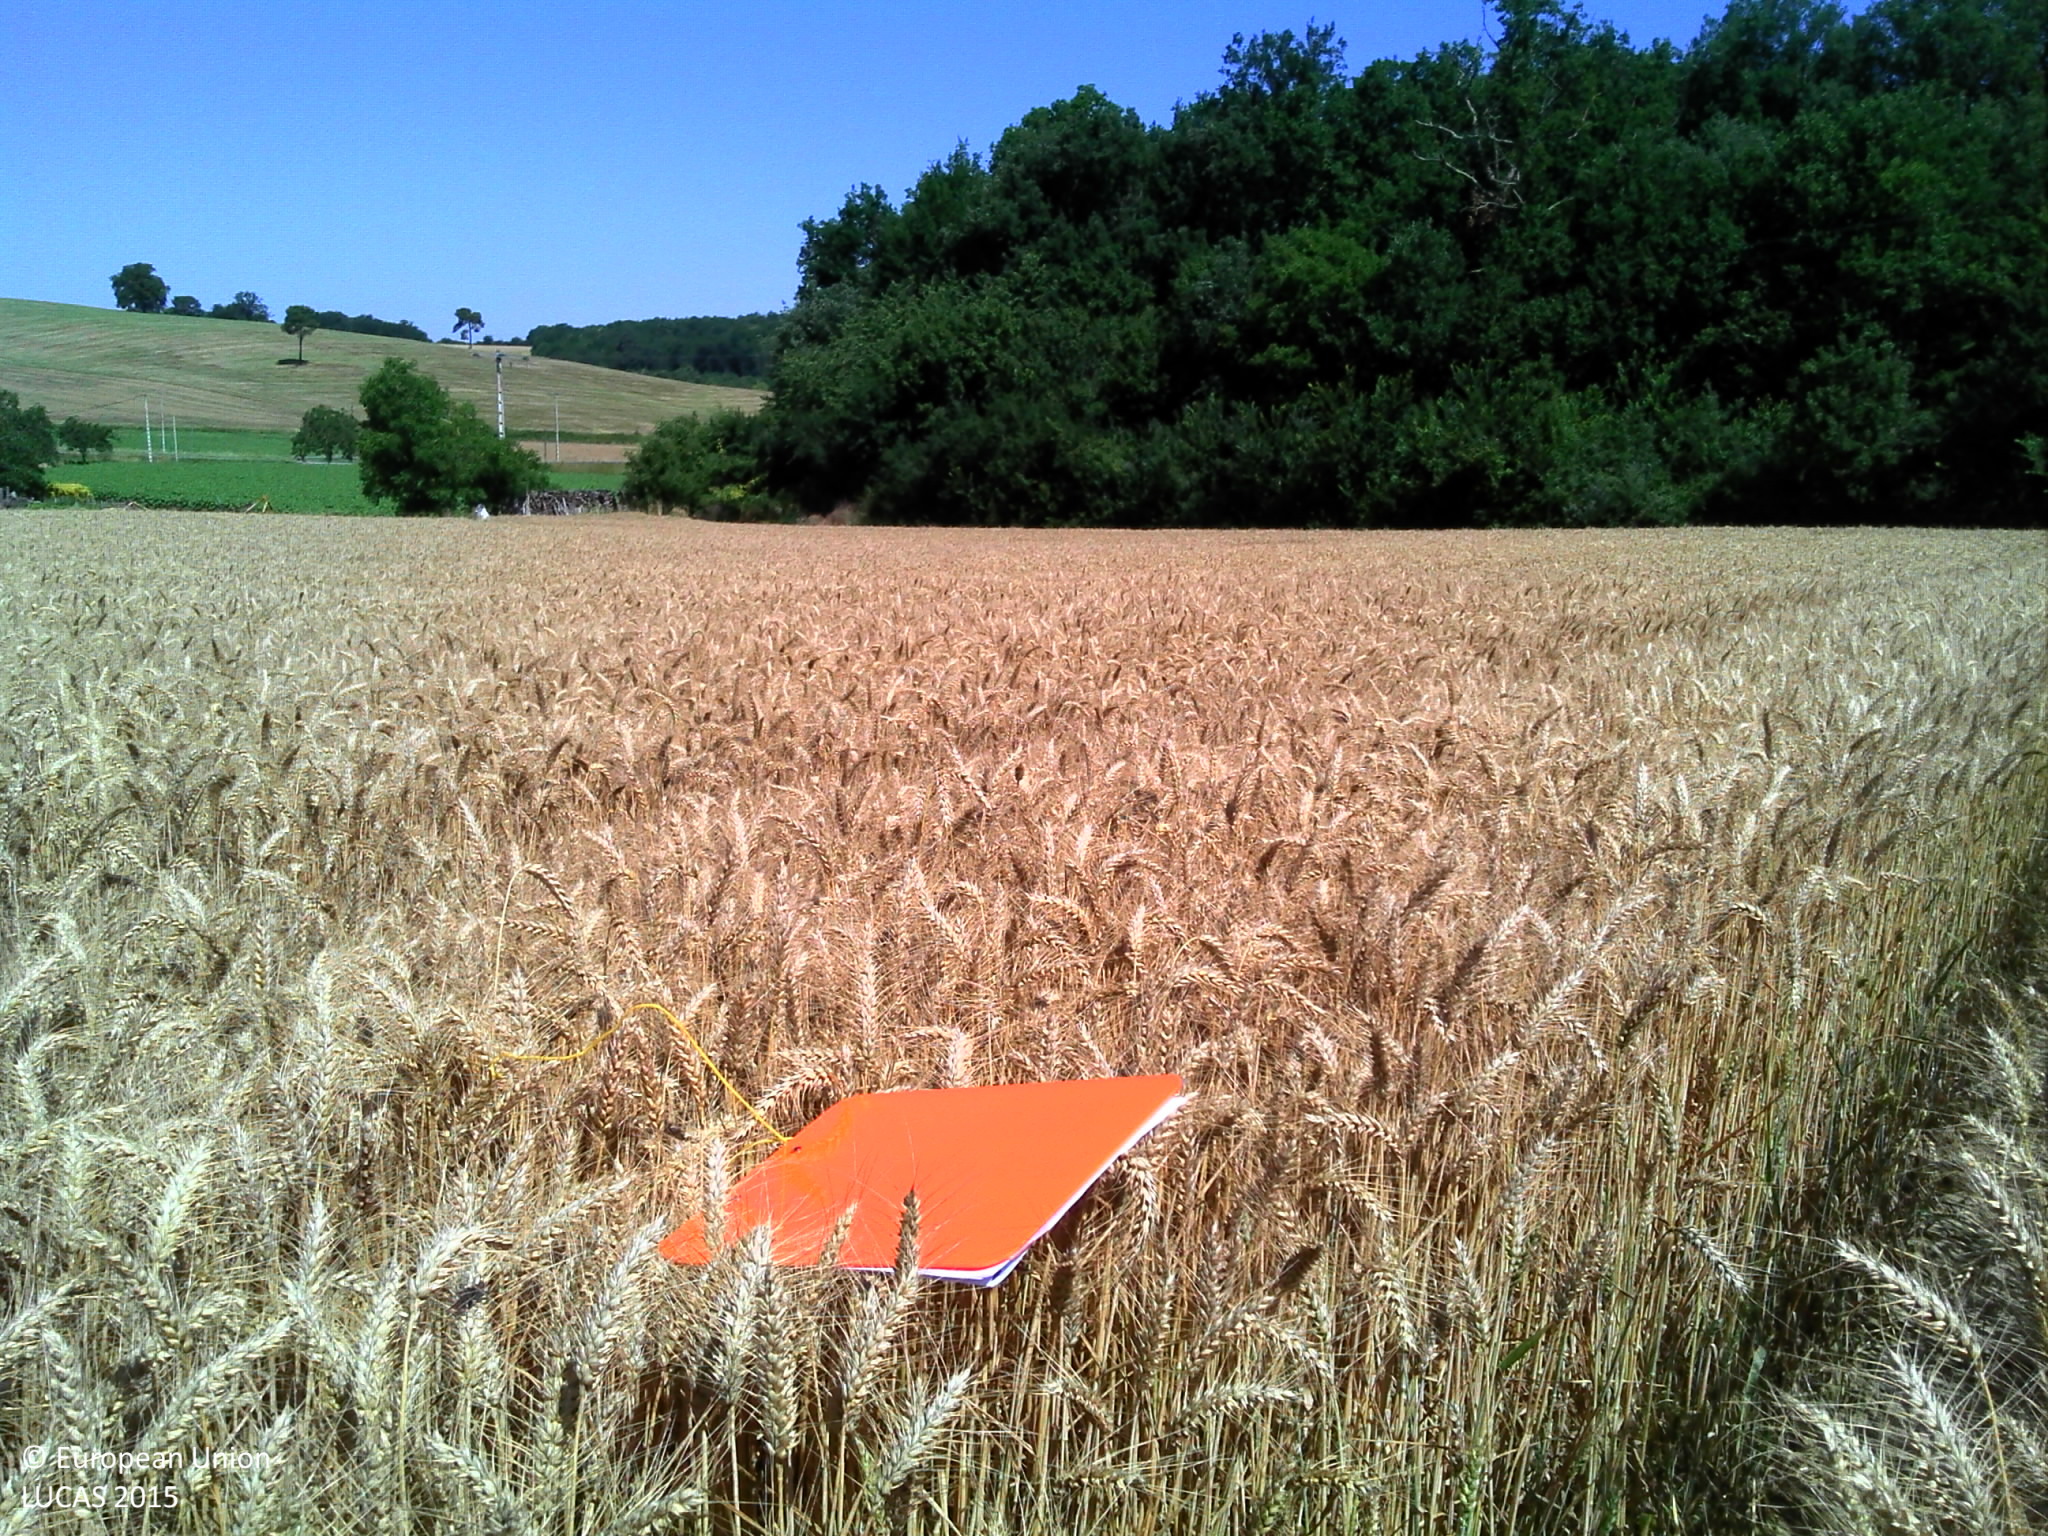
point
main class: Cropland
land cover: Common wheat
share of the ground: > 75 %
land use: Agriculture (excluding fallow land and kitchen gardens)
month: June
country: FR
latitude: 43.7788
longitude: 1.0163
